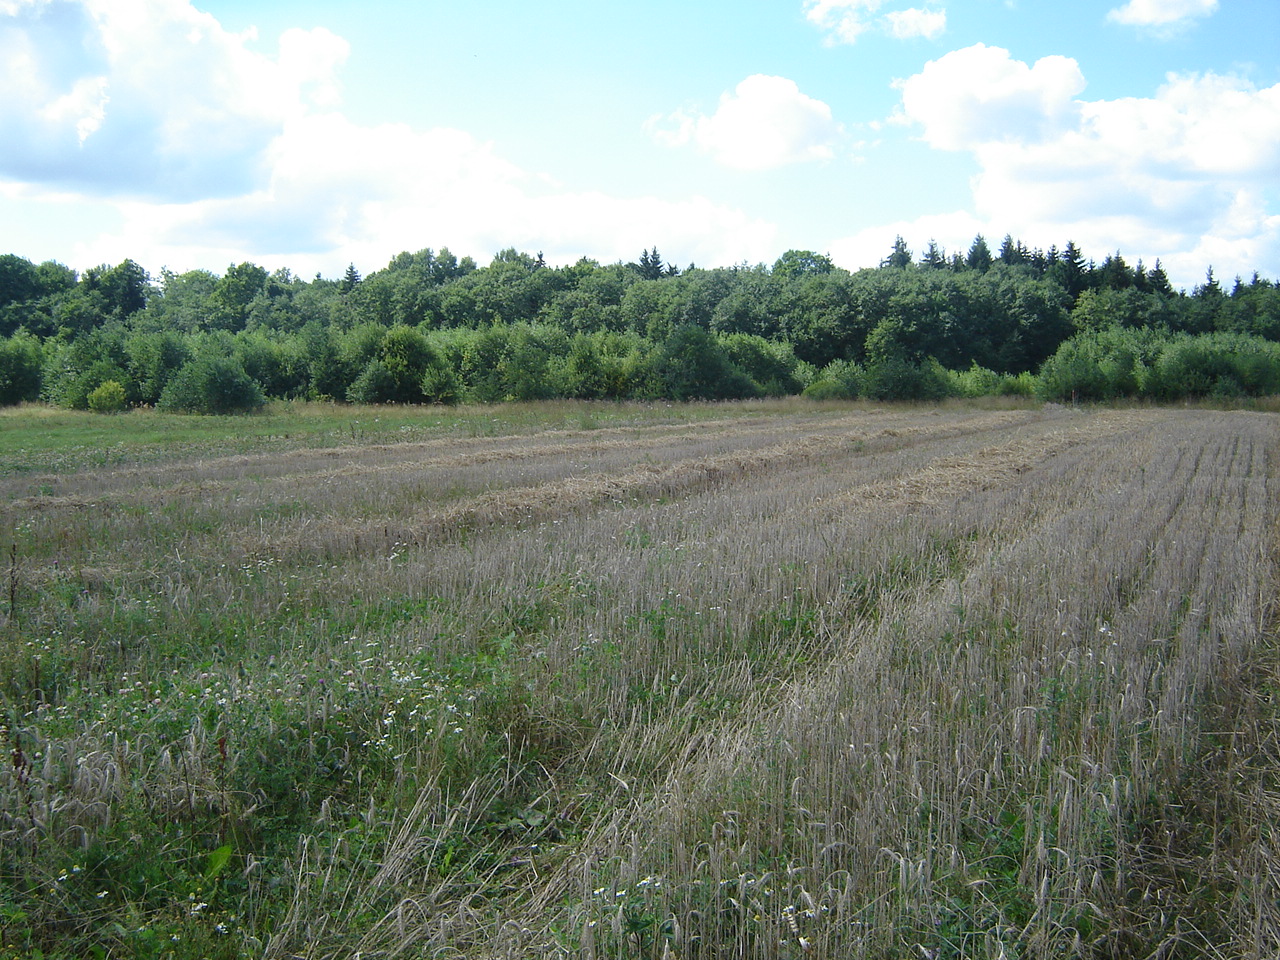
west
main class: Cropland
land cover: Durum wheat
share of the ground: > 75 %
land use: Agriculture (excluding fallow land and kitchen gardens)
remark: Harvested field
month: August
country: LT
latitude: 54.9975
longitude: 24.9150
